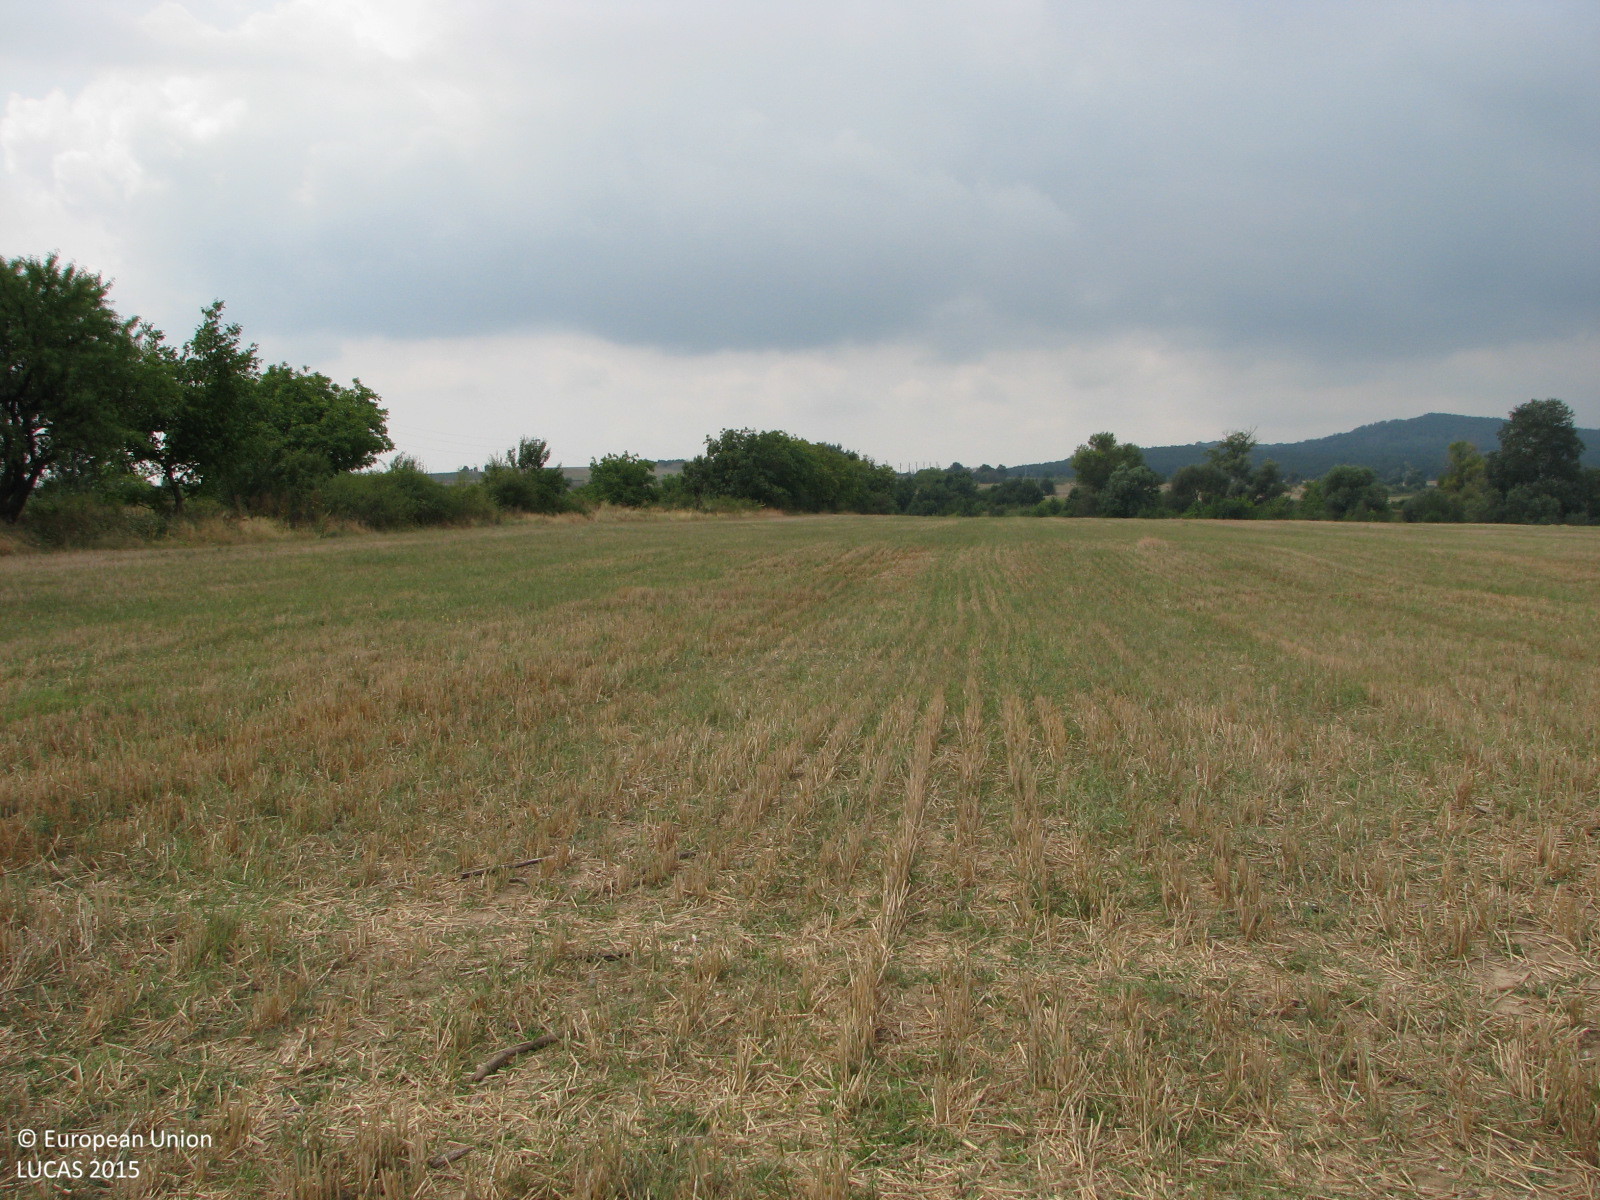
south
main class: Cropland
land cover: Common wheat
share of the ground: 25 - 50 %
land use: Agriculture (excluding fallow land and kitchen gardens)
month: August
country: BG
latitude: 42.6405
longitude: 25.9981
